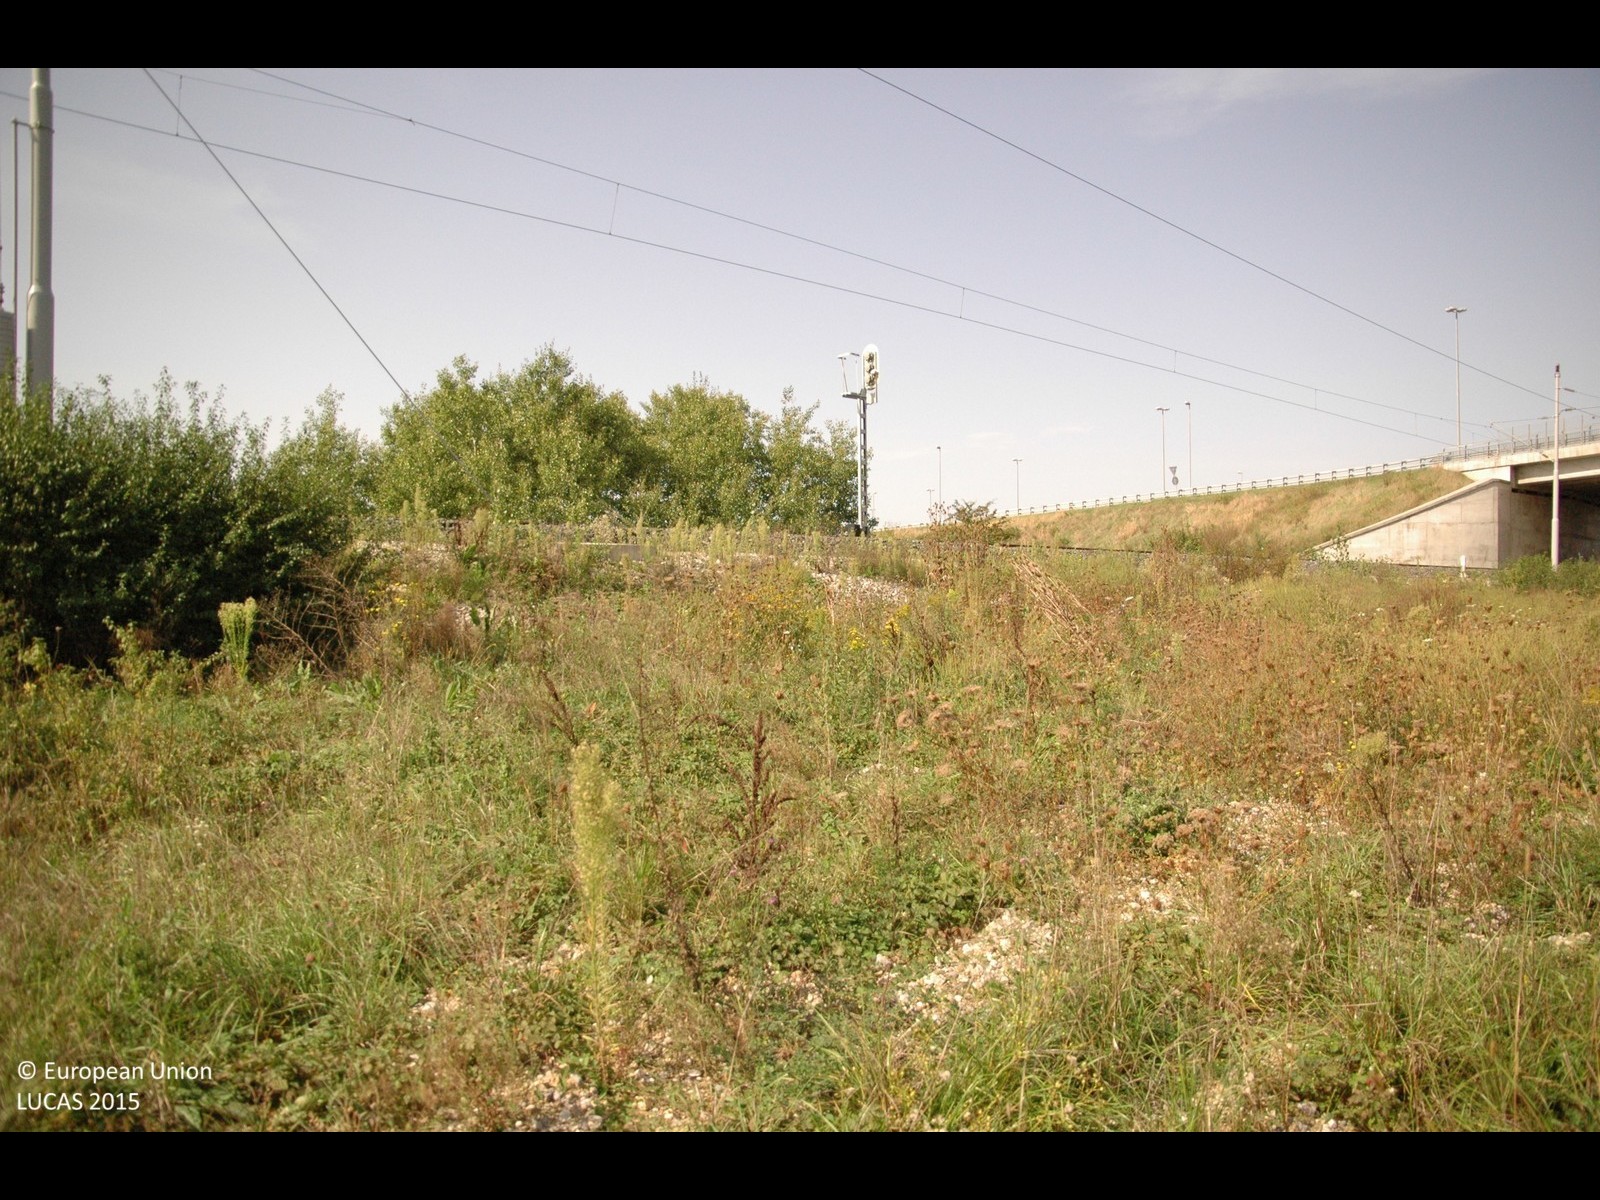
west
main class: Grassland
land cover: Grassland without tree/shrub cover
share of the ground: > 75 %
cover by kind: herbaceous plants 100 %
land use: Semi-natural and natural areas not in use
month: September
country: HR
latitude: 45.6910
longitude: 16.0716
